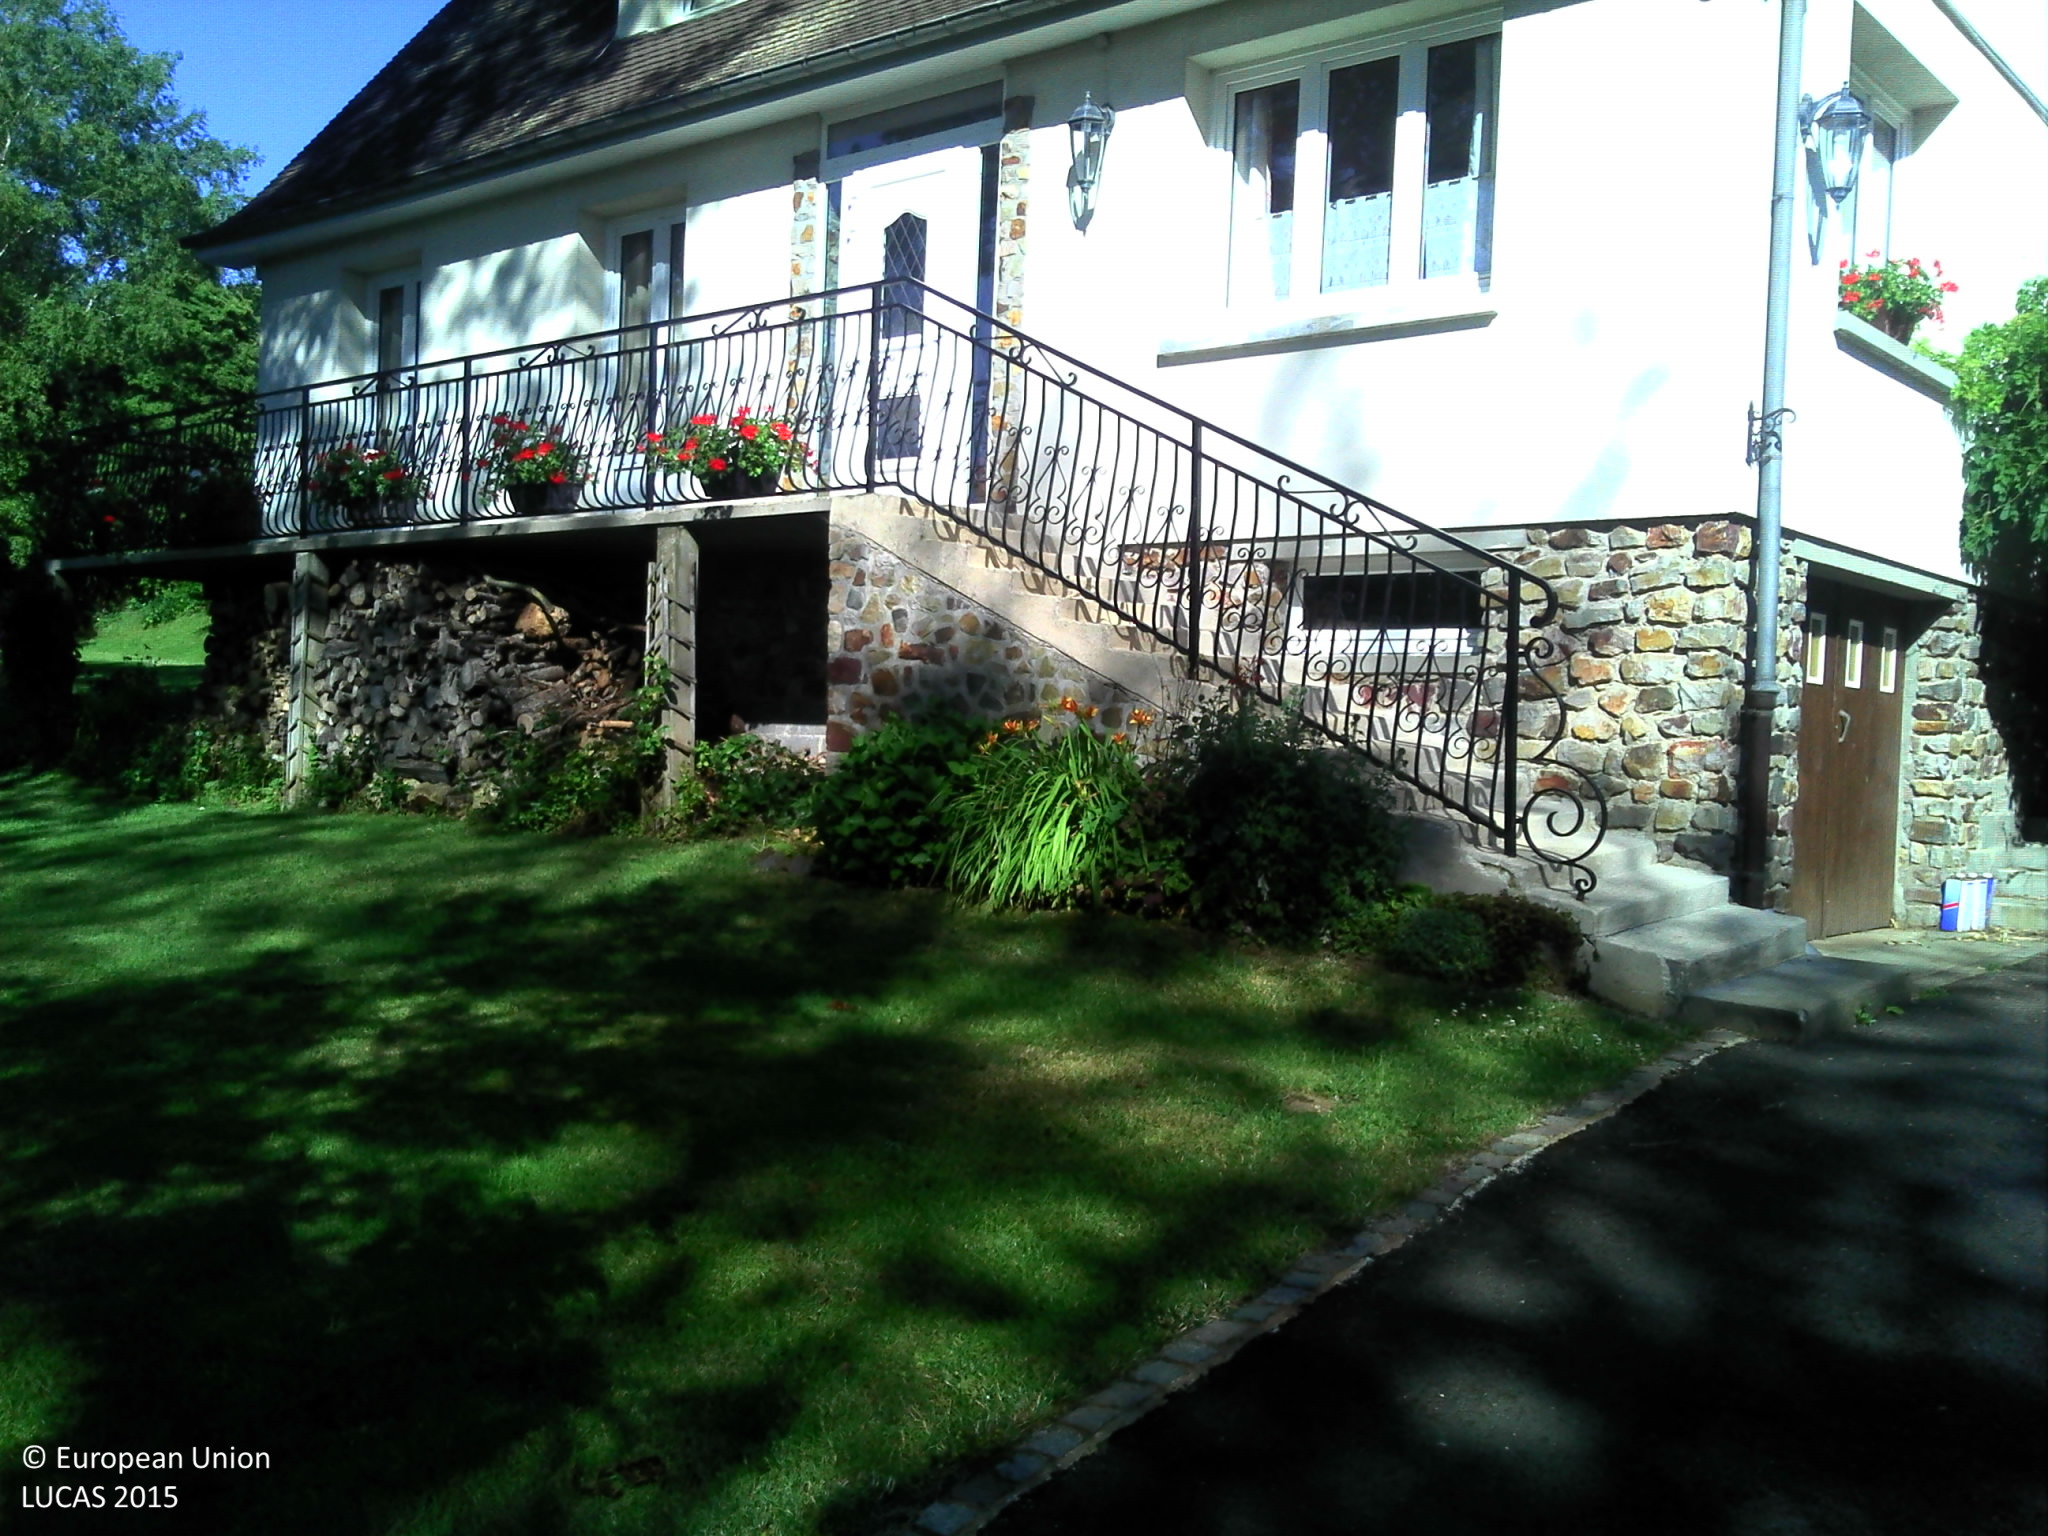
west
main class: Grassland
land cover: Grassland without tree/shrub cover
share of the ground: > 75 %
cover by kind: herbaceous plants 100 %
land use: Residential
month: July
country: FR
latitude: 48.9724
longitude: 0.5069
